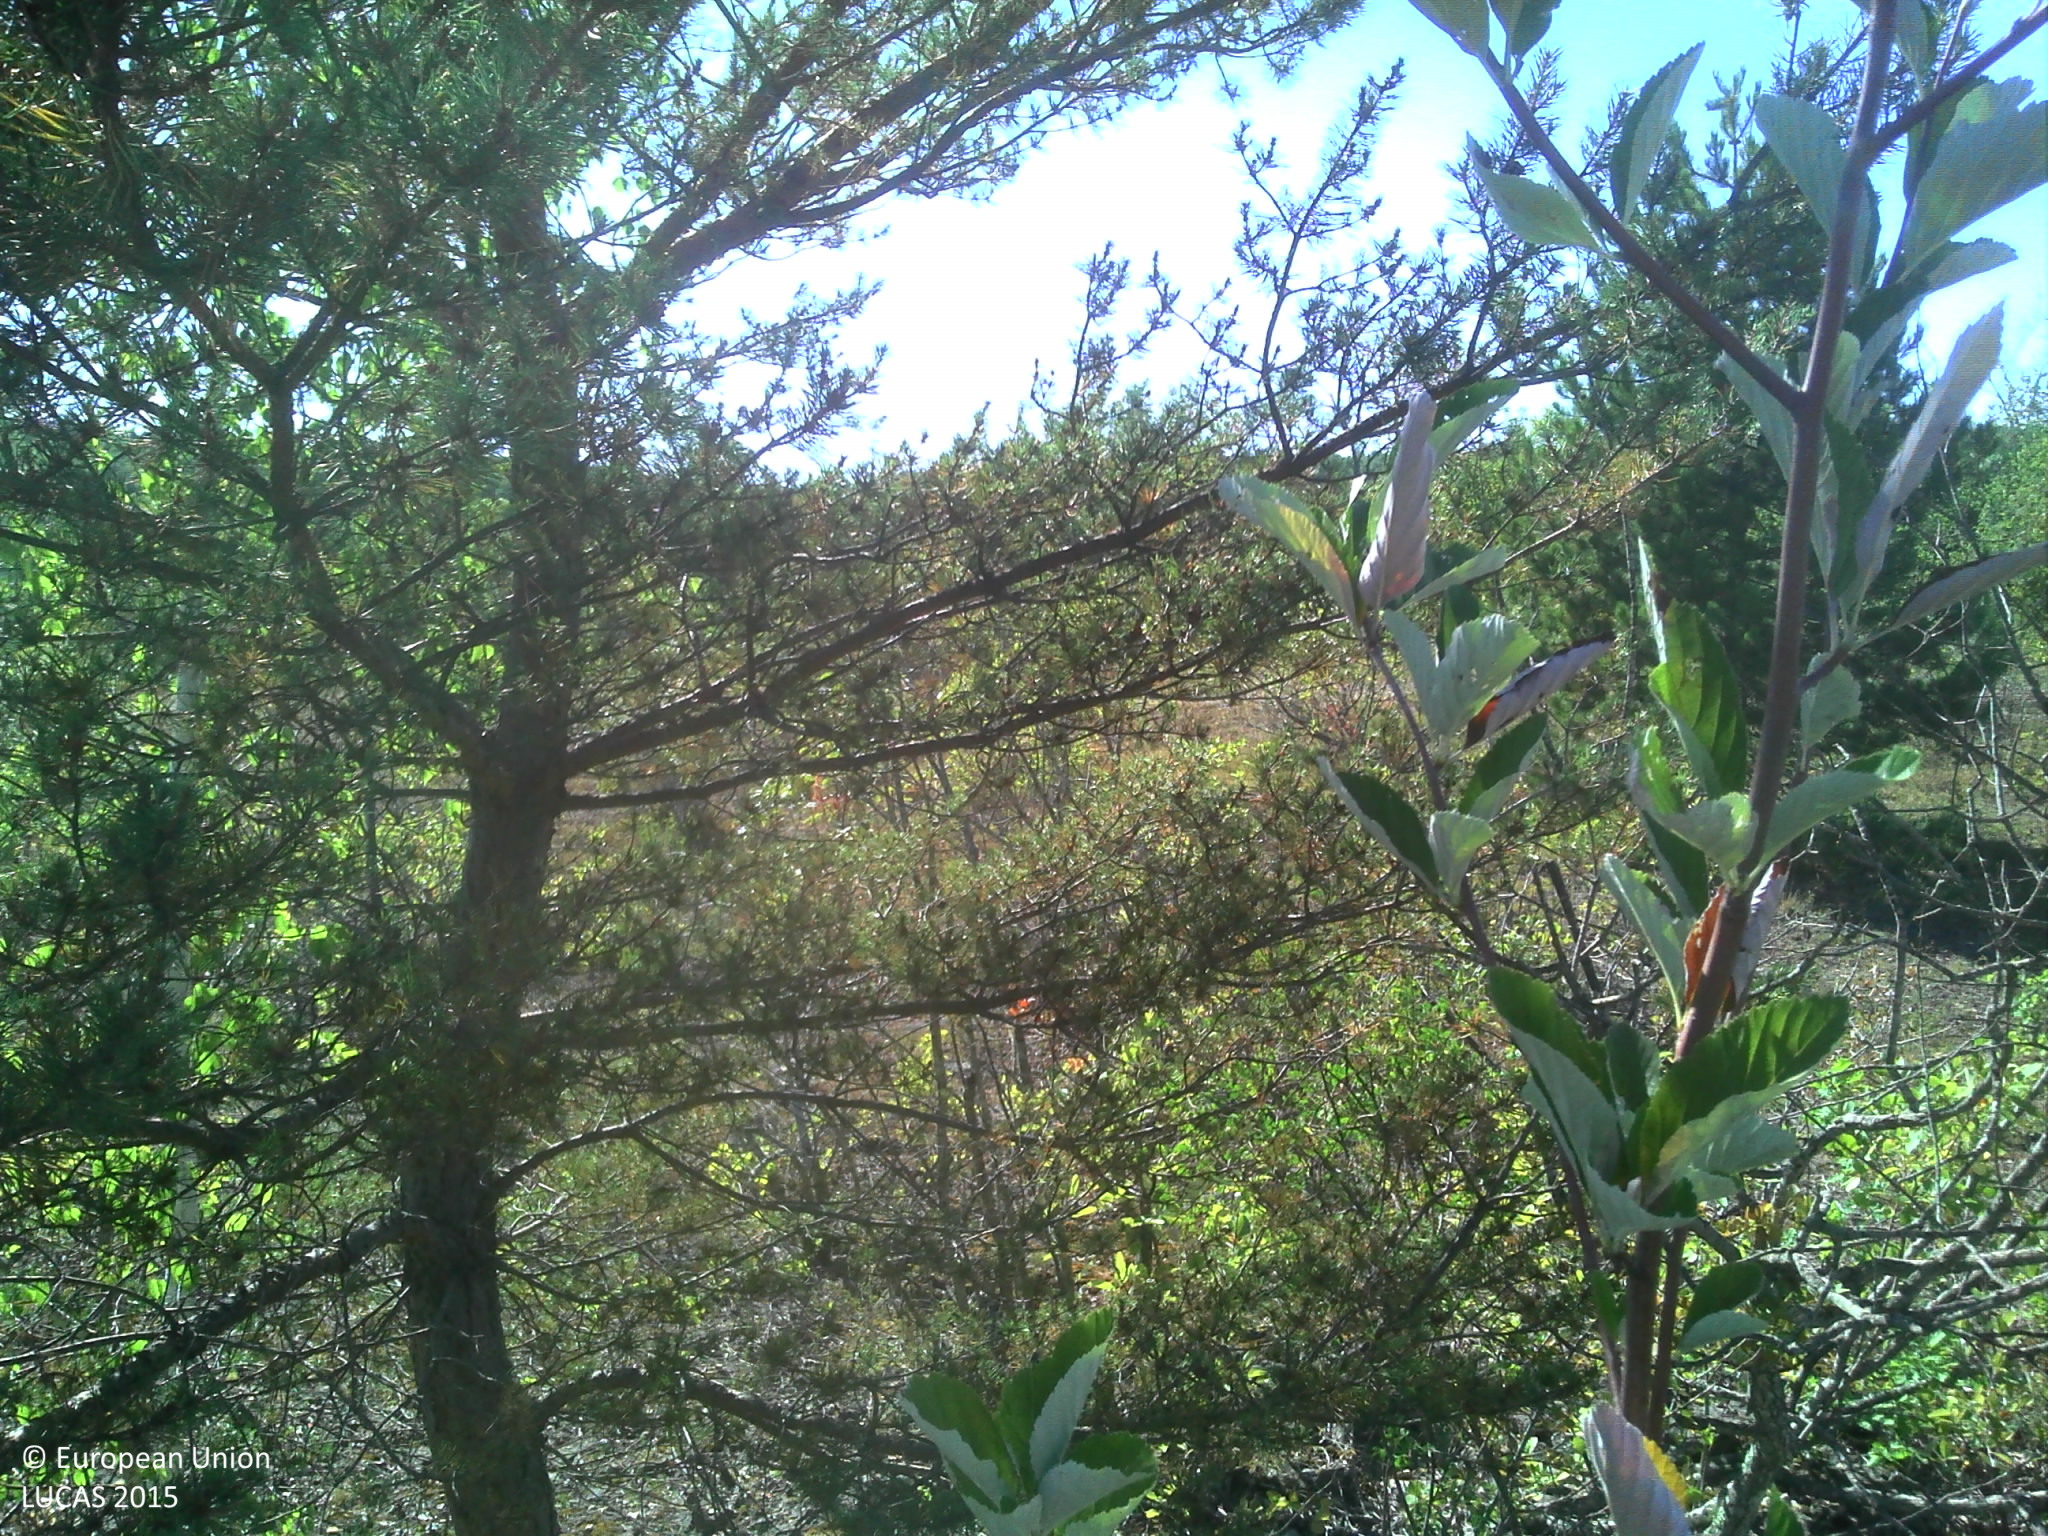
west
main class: Shrubland
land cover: Shrubland with sparse tree cover
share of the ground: > 75 %
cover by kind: shrubs 45 %, unconsolidated bare surface 30 %, herbaceous plants 20 %, broadleaved forest trees 5 %
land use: Semi-natural and natural areas not in use
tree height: < 5 m
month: July
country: FR
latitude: 46.8535
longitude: 4.7417
